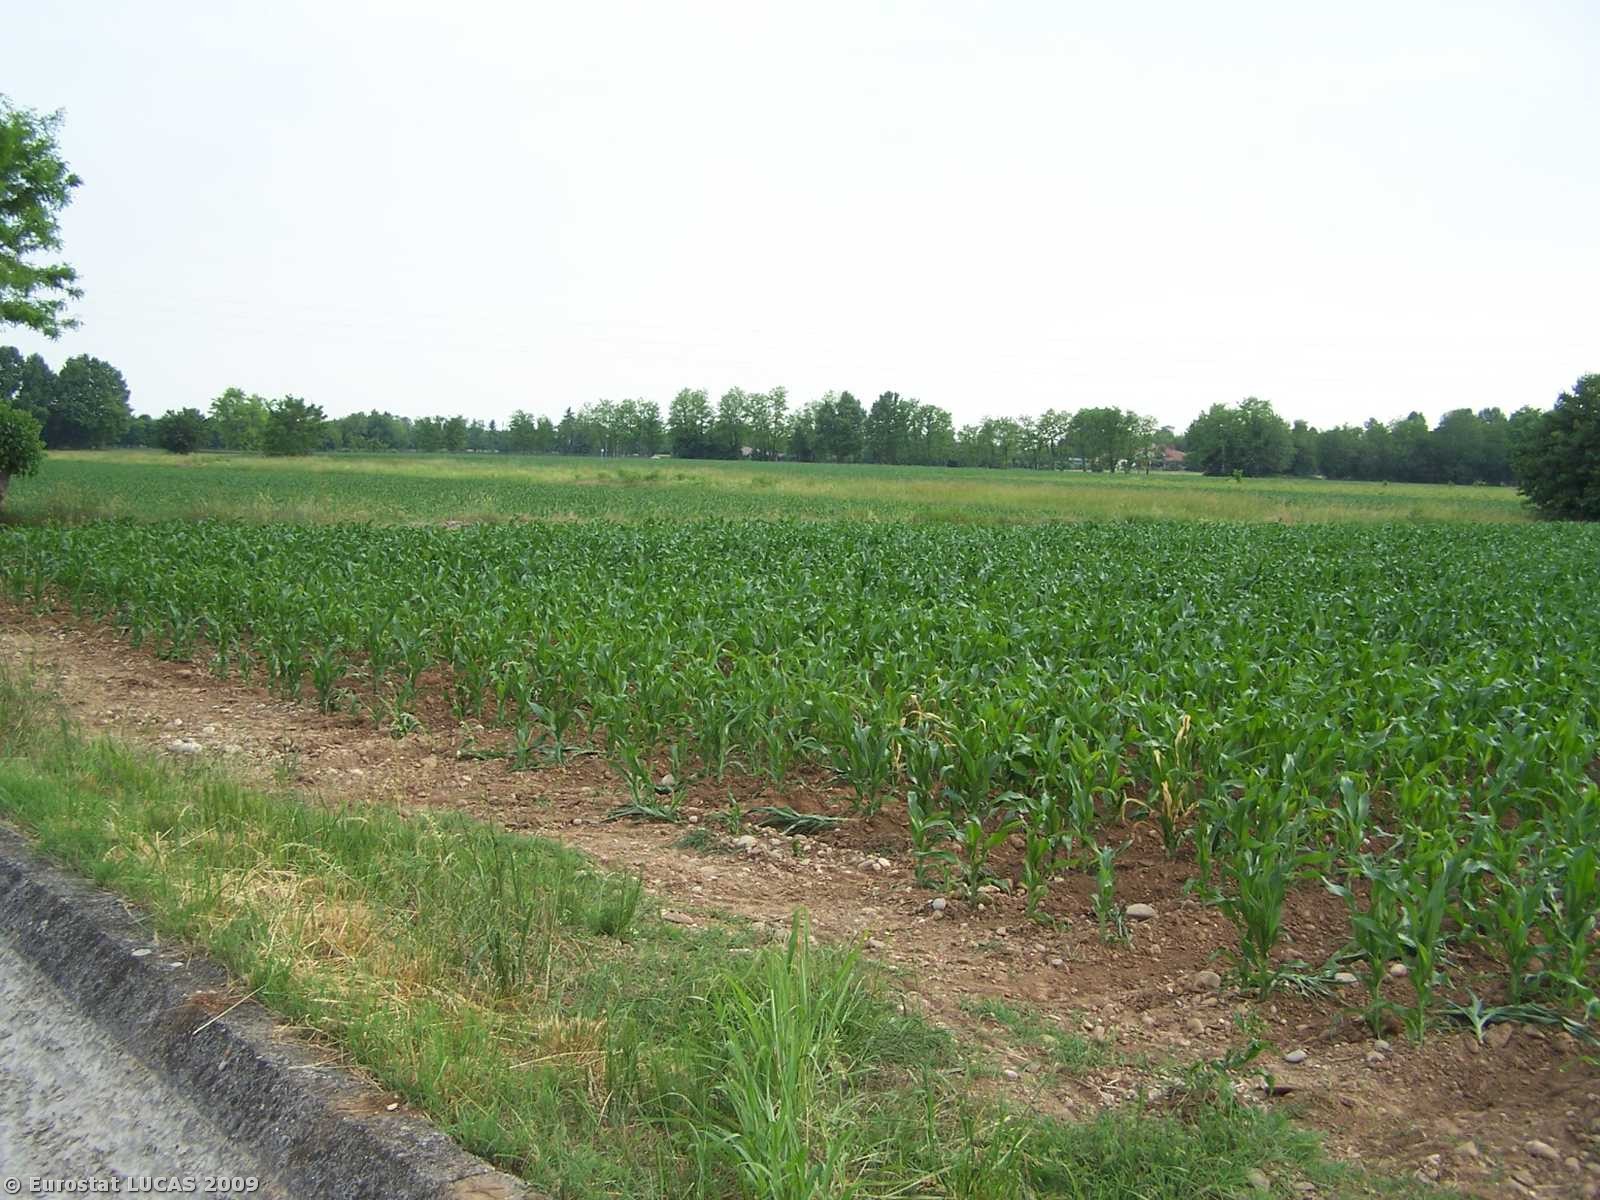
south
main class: Cropland
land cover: Maize
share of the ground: 50 - 75 %
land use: Agriculture (excluding fallow land and kitchen gardens)
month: May
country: IT
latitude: 45.9853
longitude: 12.9784
